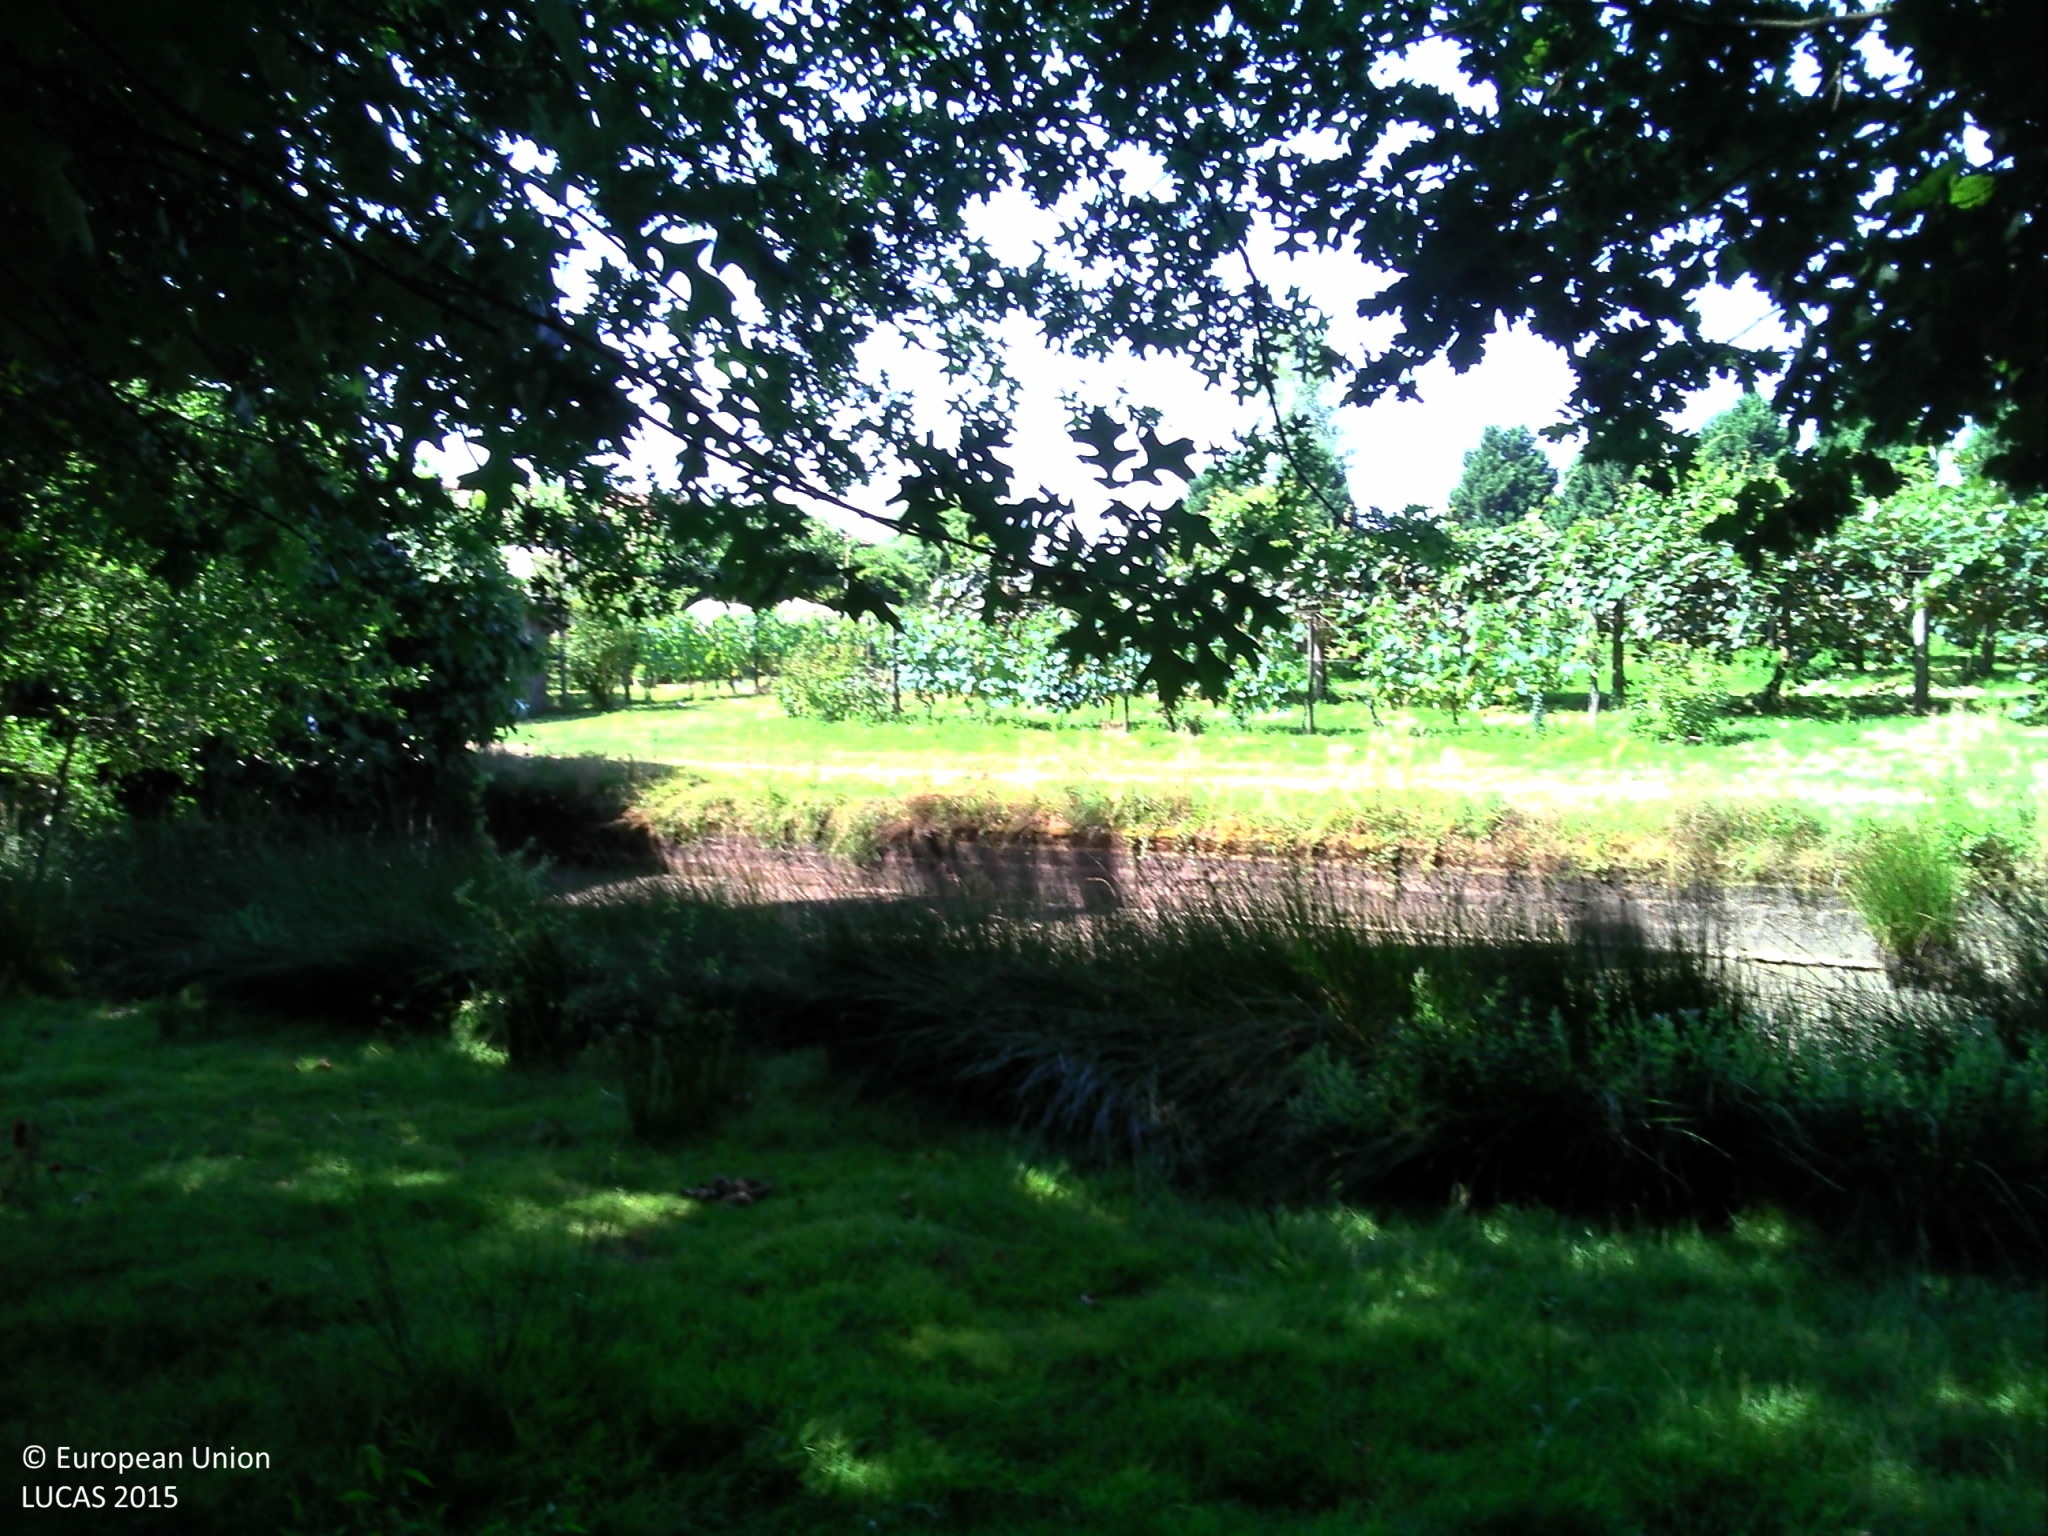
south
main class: Woodland
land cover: Broadleaved woodland
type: mesophytic deciduous forest
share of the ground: > 75 %
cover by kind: broadleaved forest trees 60 %, herbaceous plants 35 %, lichens and mosses 5 %
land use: Forestry
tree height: > 5 m
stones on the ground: < 10 %
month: August
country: FR
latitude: 43.7739
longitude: -0.7349
